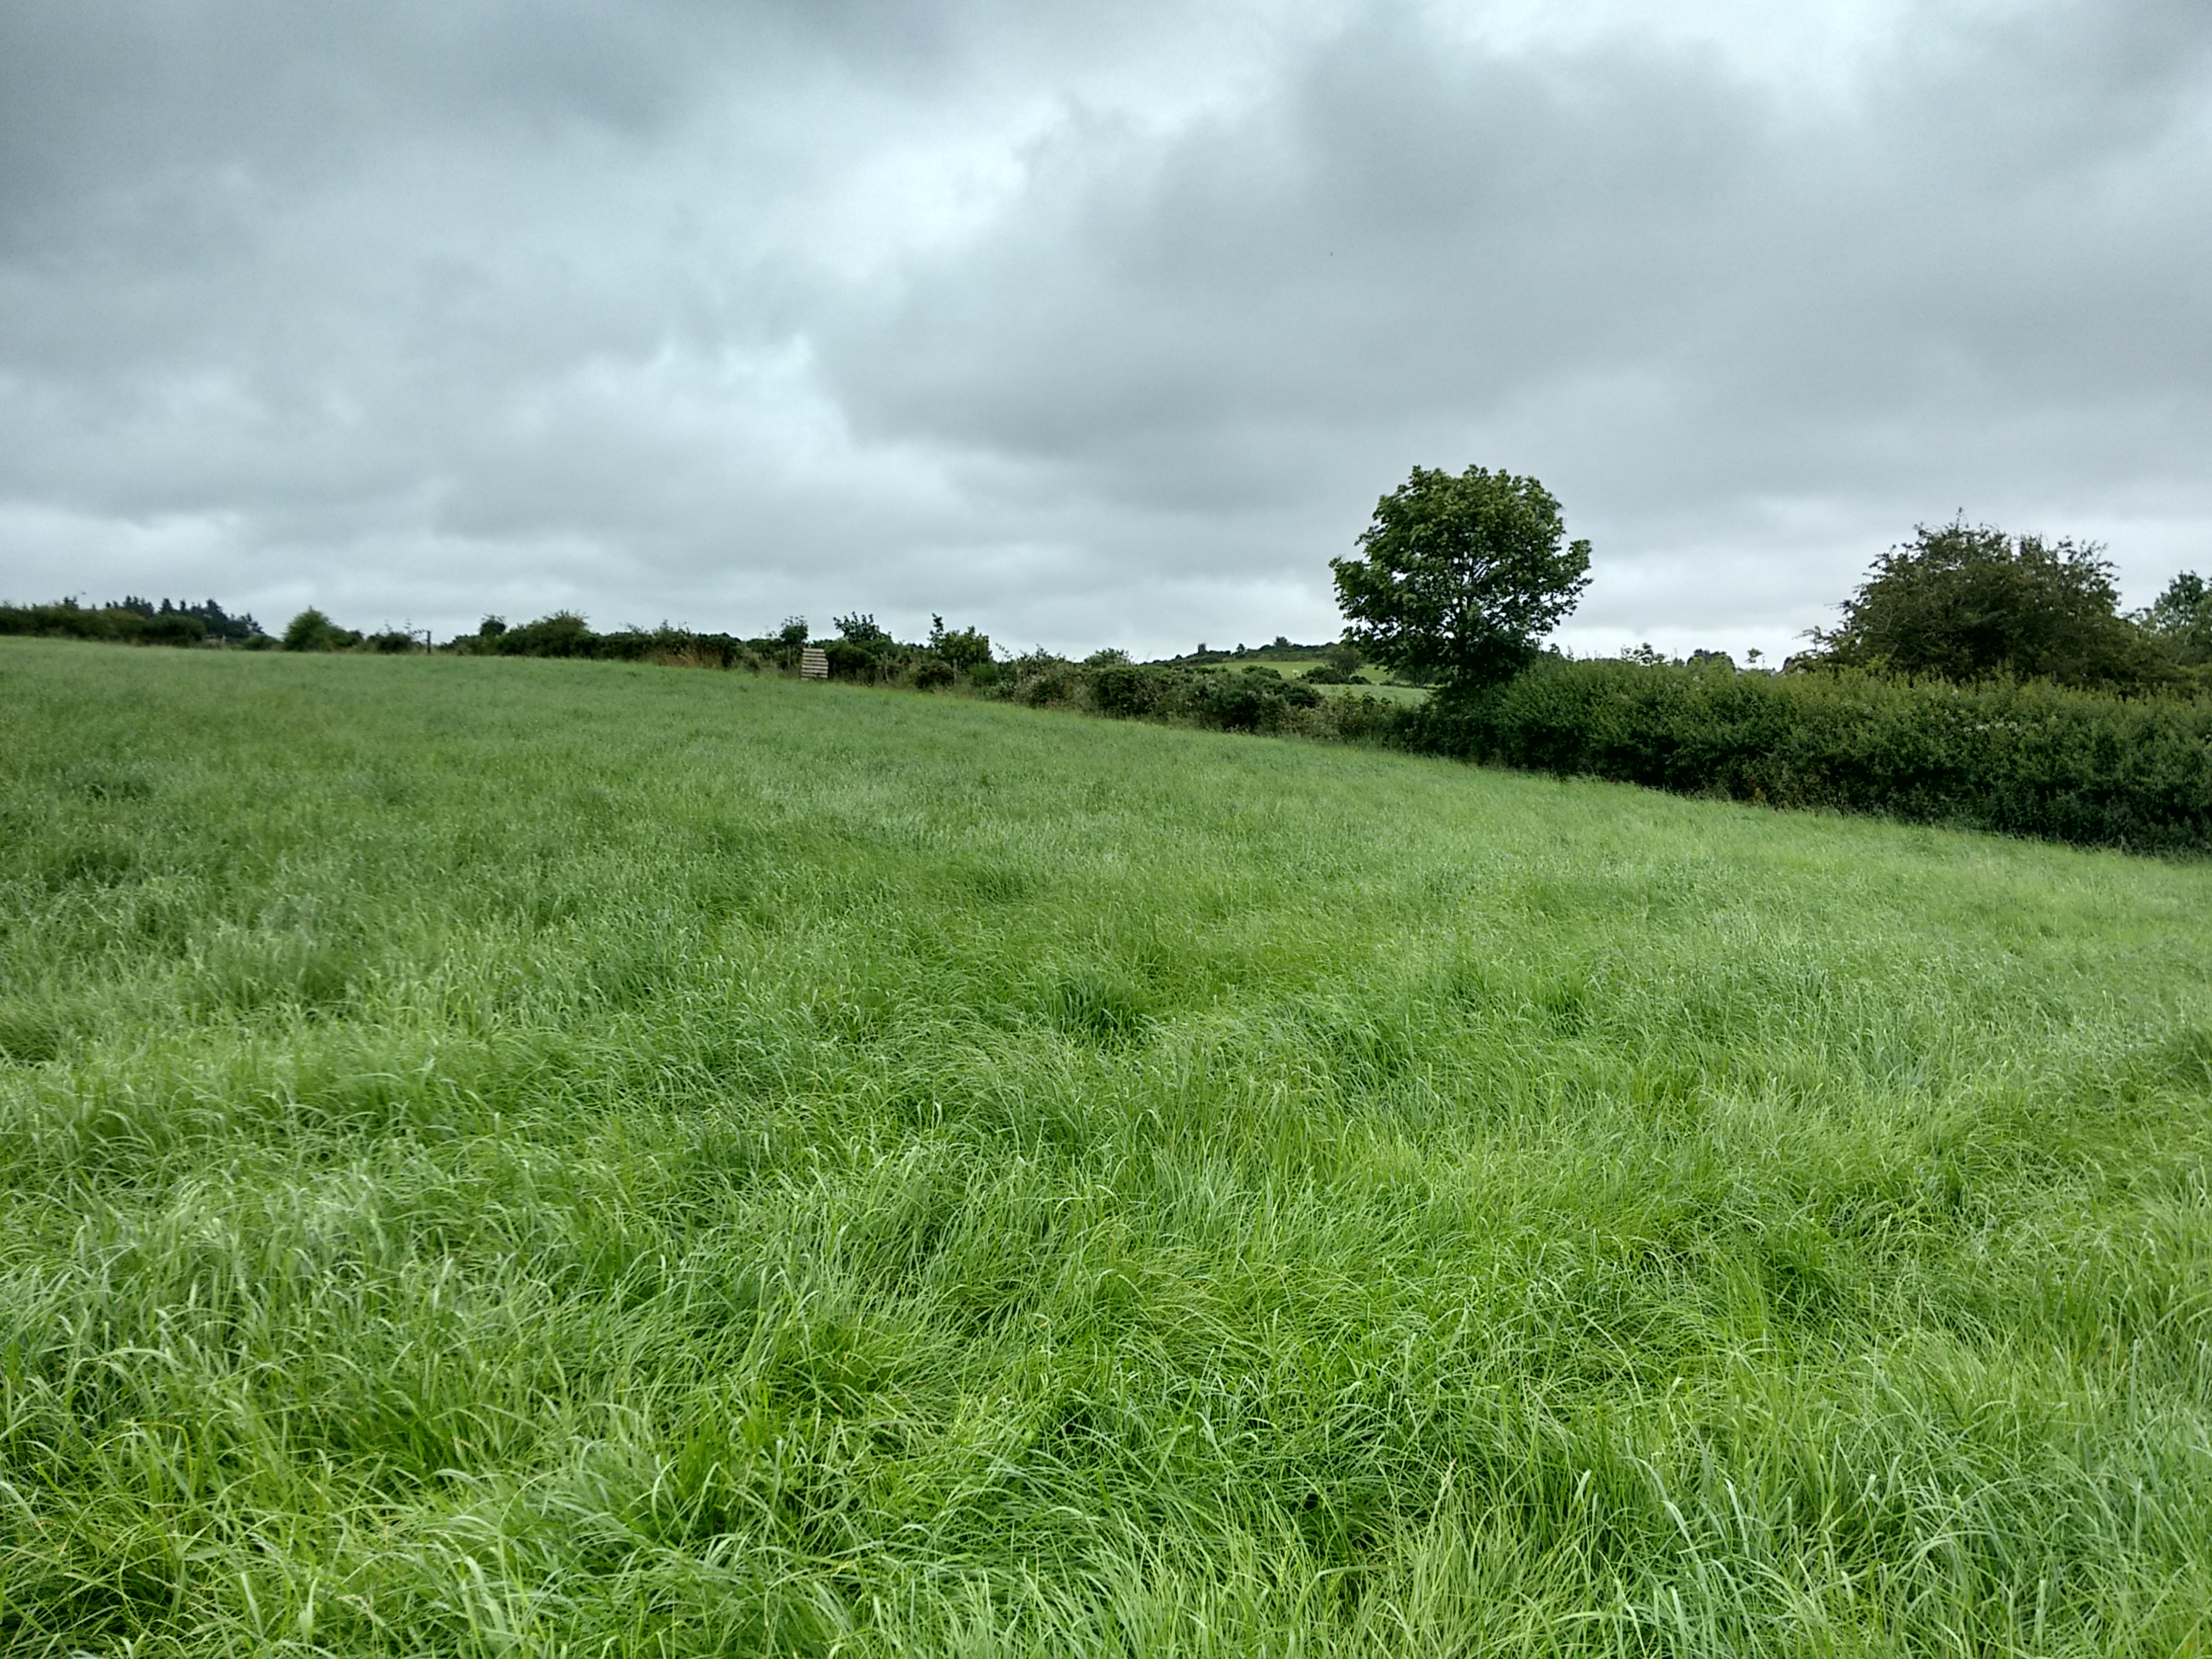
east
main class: Grassland
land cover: Grassland without tree/shrub cover
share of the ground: > 75 %
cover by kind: herbaceous plants 100 %
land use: Agriculture (excluding fallow land and kitchen gardens)
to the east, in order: Grassland without tree/shrub cover; Fences; Abandoned hedges; Tracks; Abandoned hedges; Fences; Grassland without tree/shrub cover; Fences; Abandoned hedges; Grassland without tree/shrub cover; Abandoned hedges; Fences; Grass margins; Fences; Grassland without tree/shrub cover
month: August
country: GB
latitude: 54.6115
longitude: -6.9050
